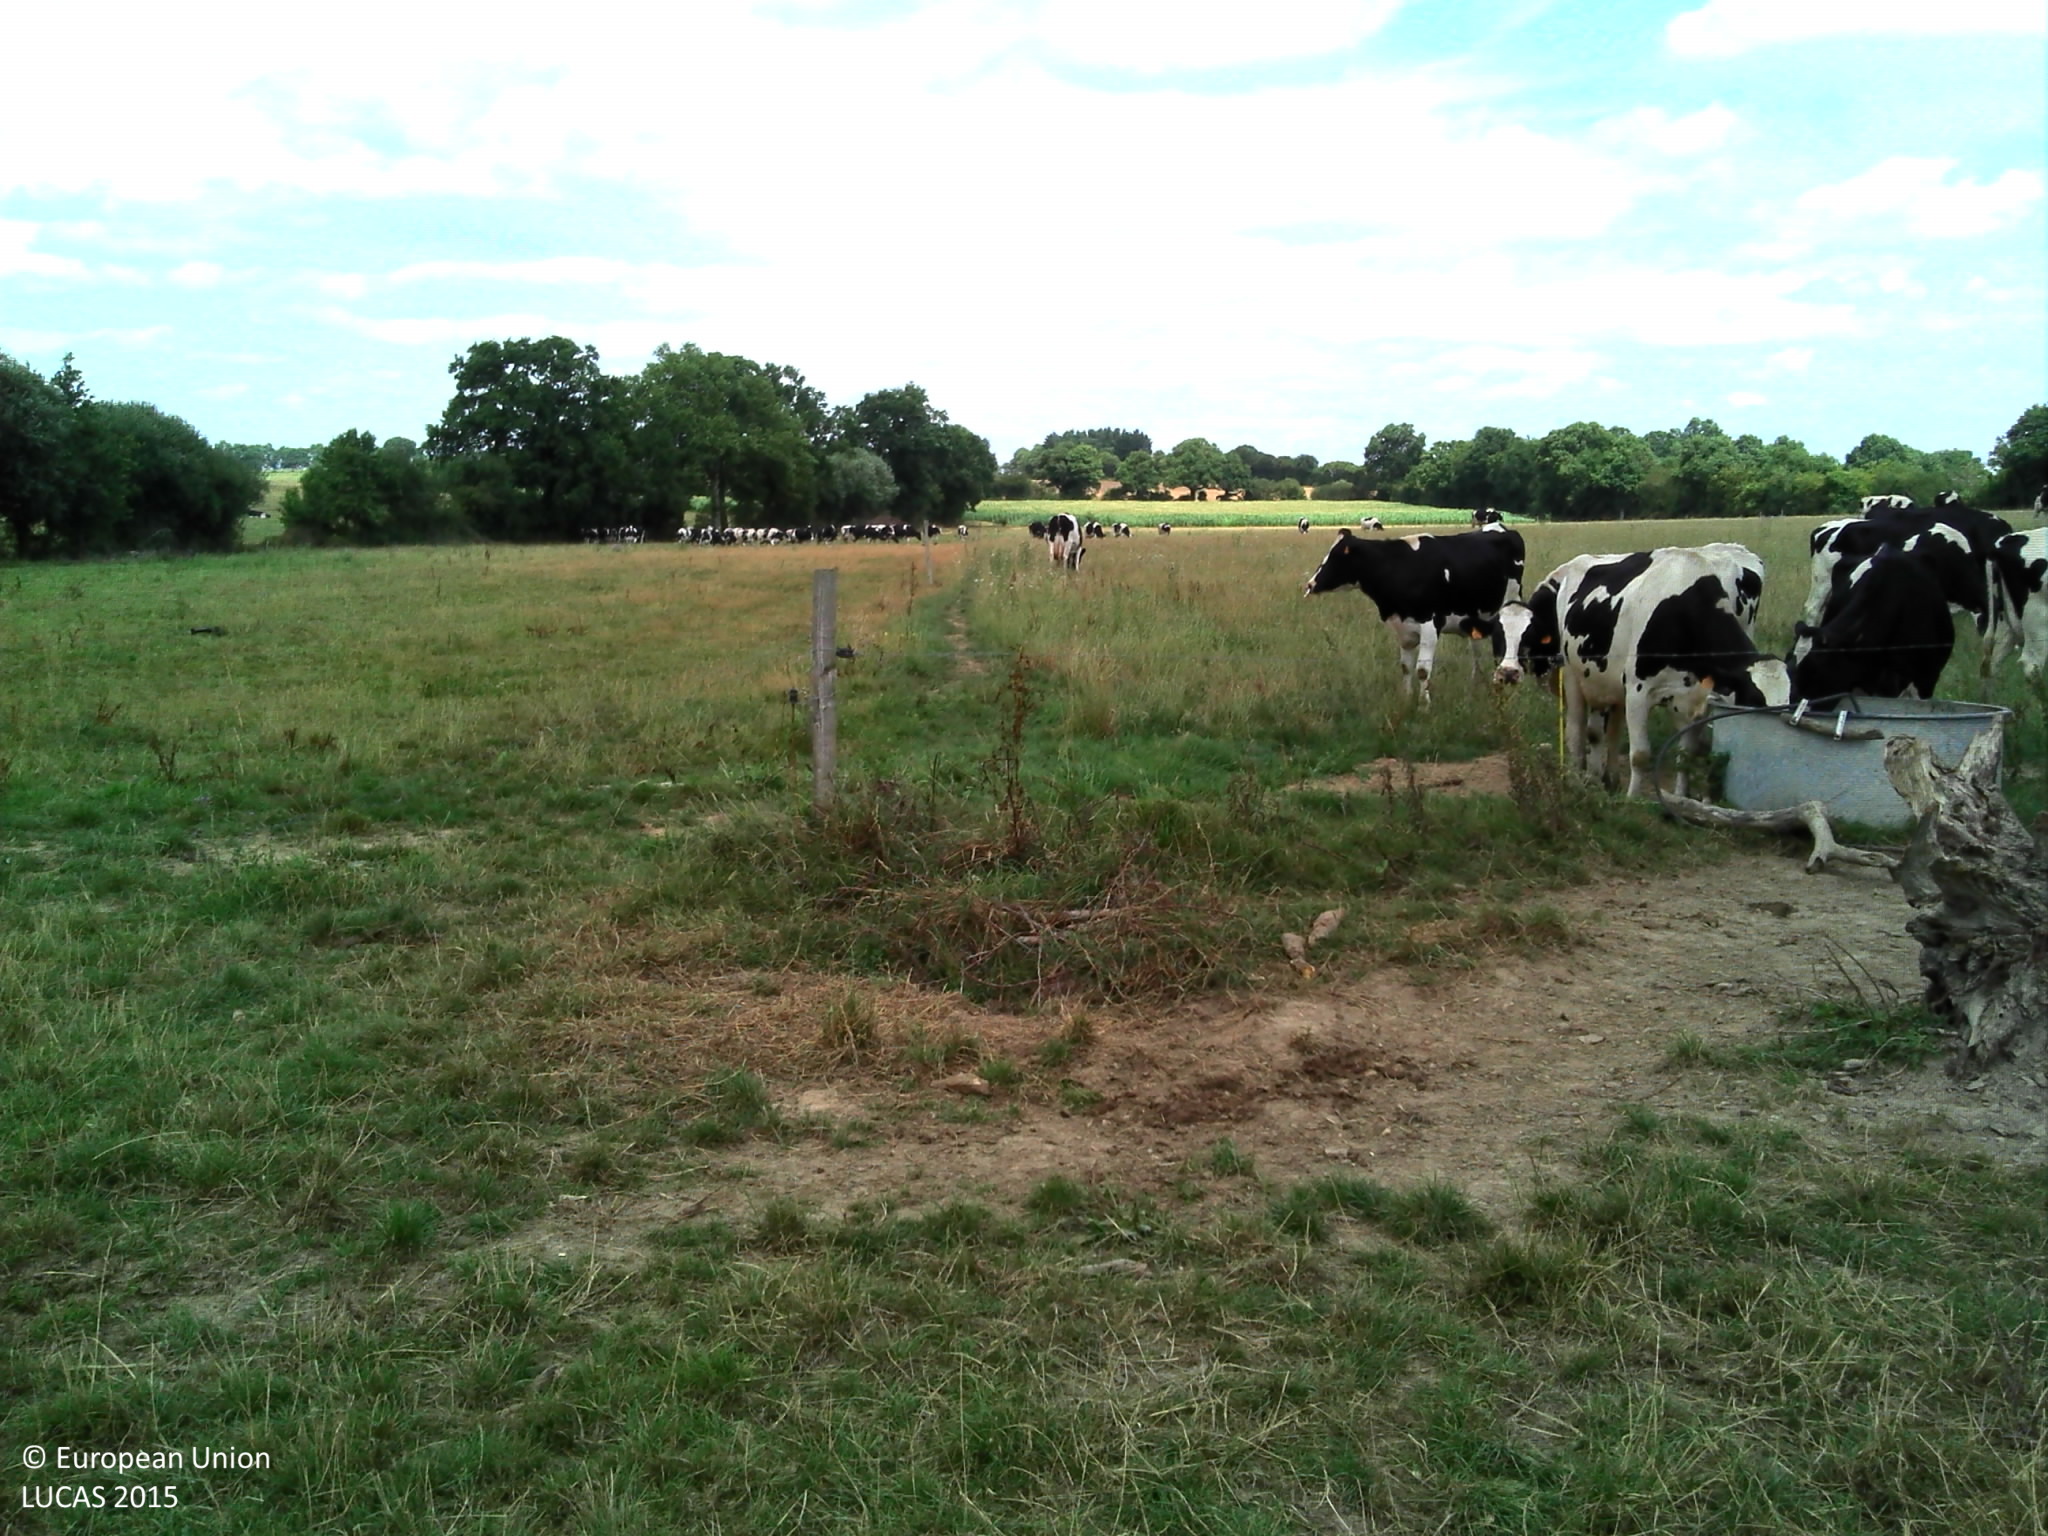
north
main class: Grassland
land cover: Grassland without tree/shrub cover
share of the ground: > 75 %
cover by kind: herbaceous plants 100 %
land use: Agriculture (excluding fallow land and kitchen gardens)
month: August
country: FR
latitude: 47.7427
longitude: -1.3650
